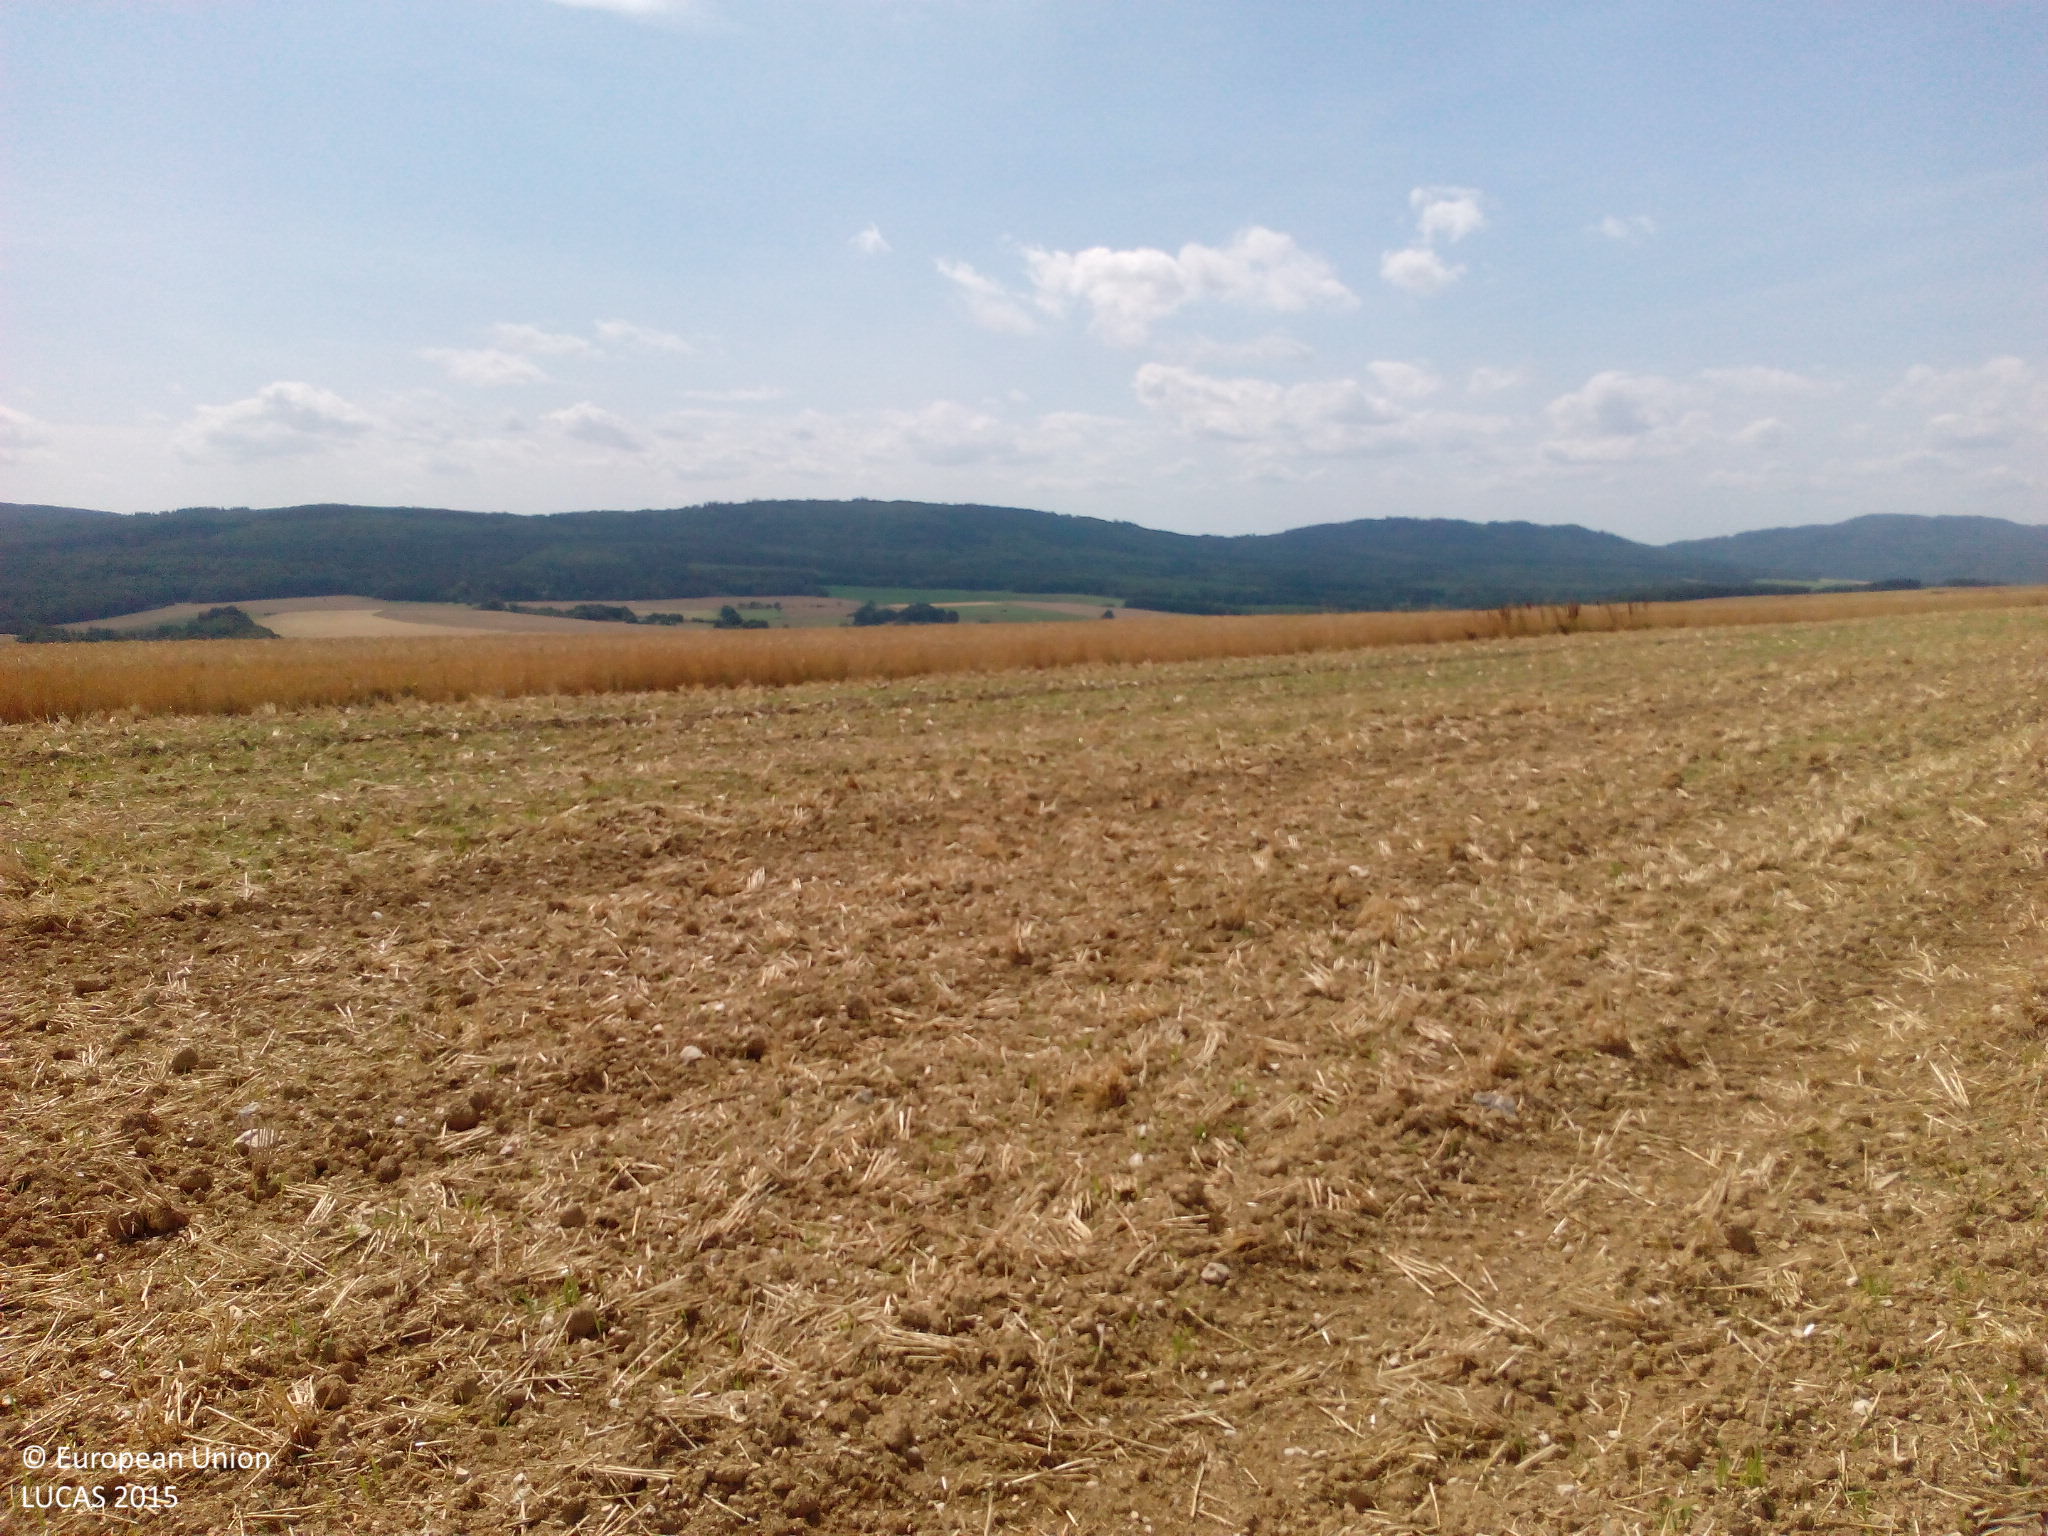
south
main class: Cropland
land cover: Barley
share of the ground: < 10 %
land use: Agriculture (excluding fallow land and kitchen gardens)
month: July
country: DE
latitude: 49.9231
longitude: 7.5071
